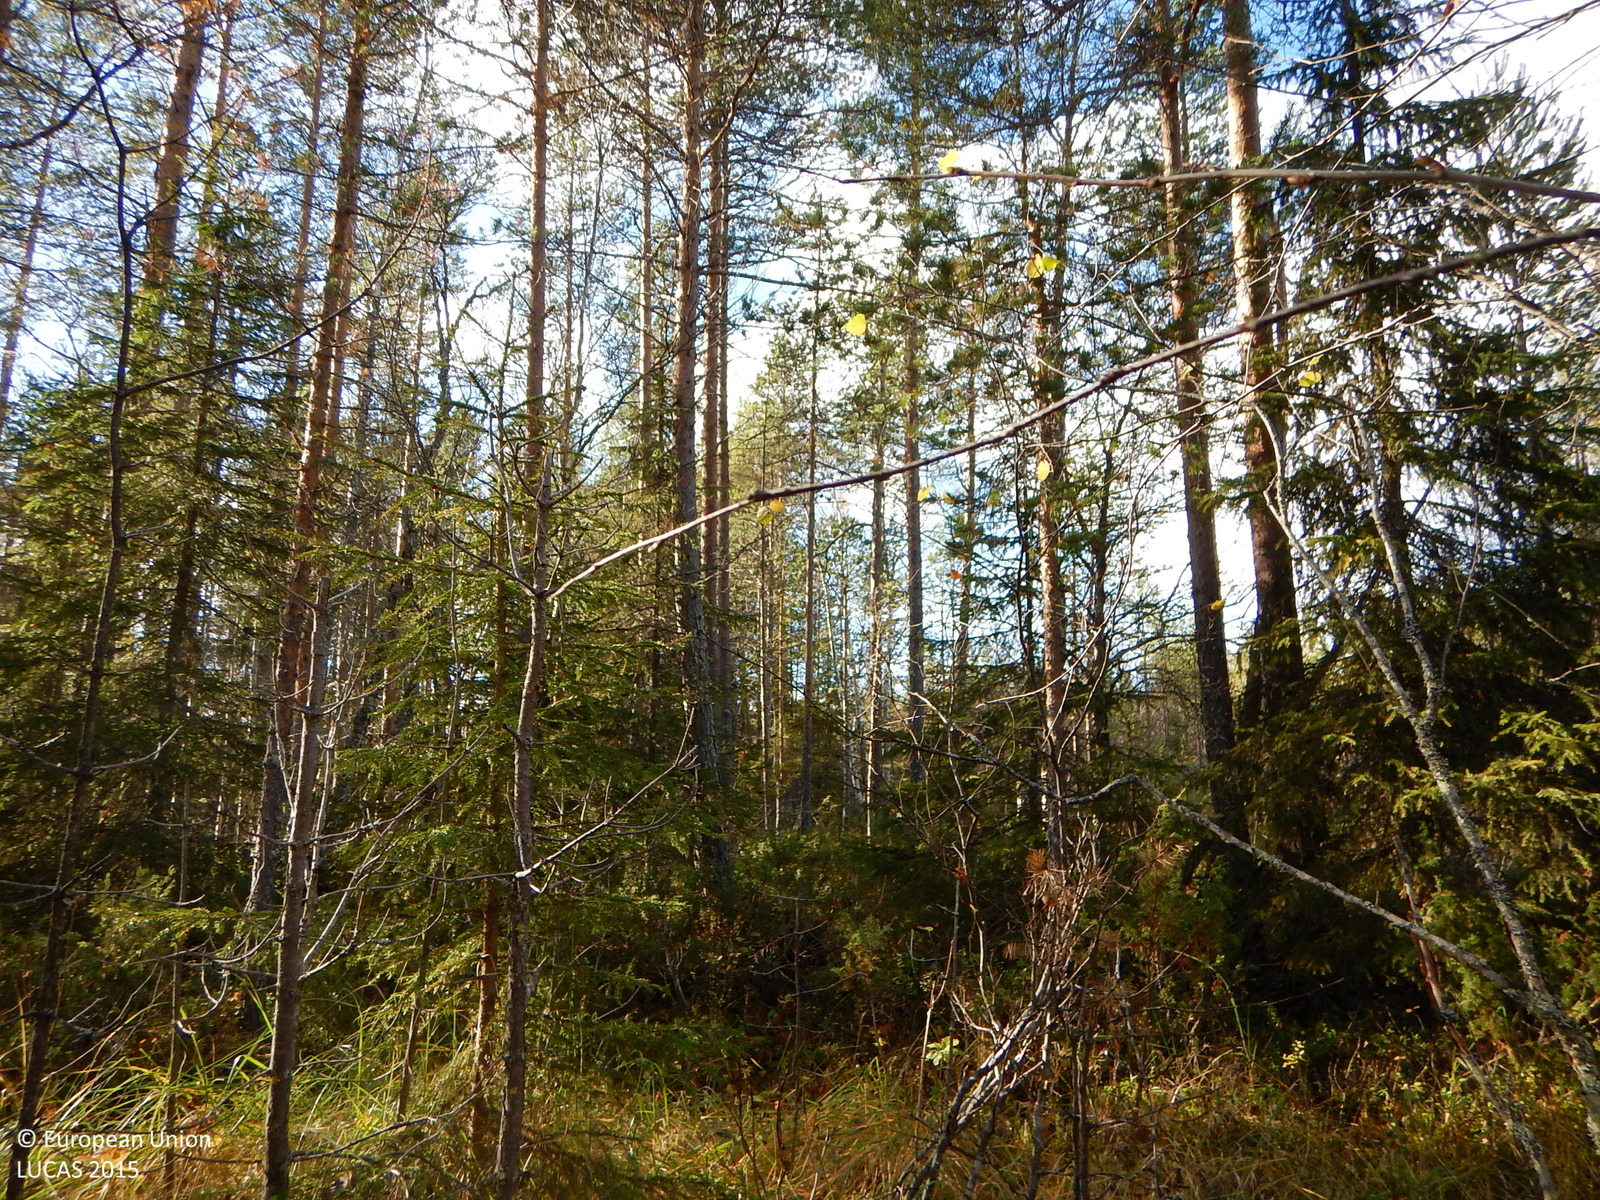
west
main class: Woodland
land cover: Pine dominated mixed woodland
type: boreal forest
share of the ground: 50 - 75 %
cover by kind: coniferous forest trees 50 %, broadleaved forest trees 20 %, shrubs 15 %, herbaceous plants 15 %
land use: Forestry
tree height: > 5 m
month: September
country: SE
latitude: 64.9299
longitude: 20.1445
